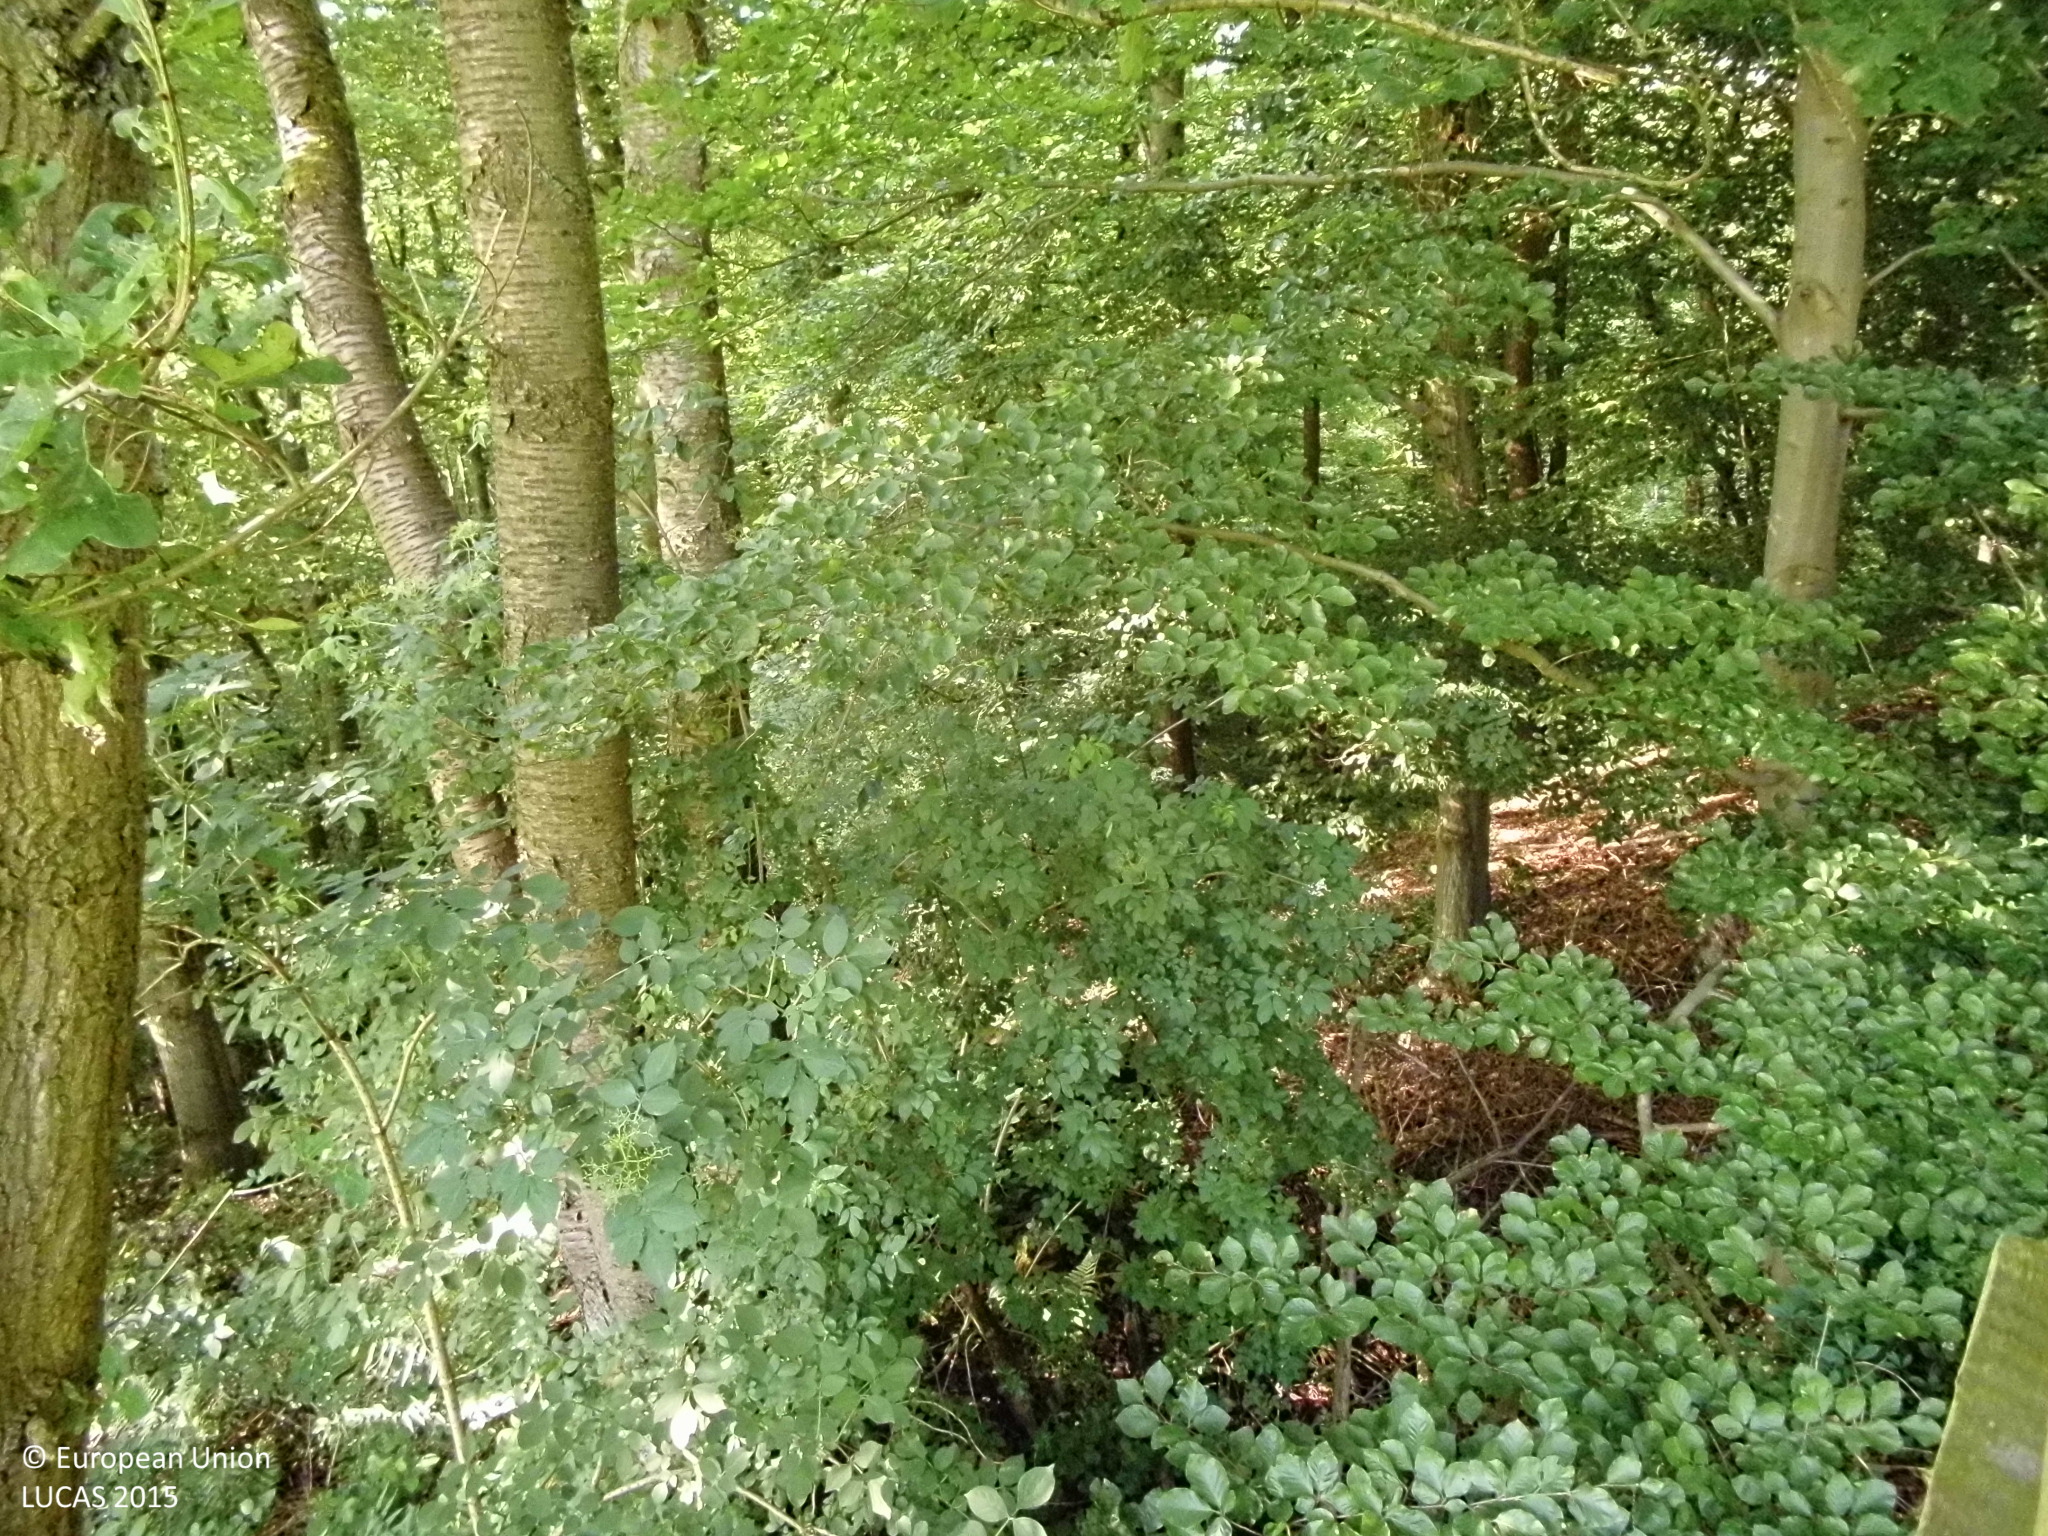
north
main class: Grassland
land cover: Grassland without tree/shrub cover
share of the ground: > 75 %
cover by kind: herbaceous plants 100 %
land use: Agriculture (excluding fallow land and kitchen gardens)
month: June
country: DE
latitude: 50.7856
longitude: 7.4612
